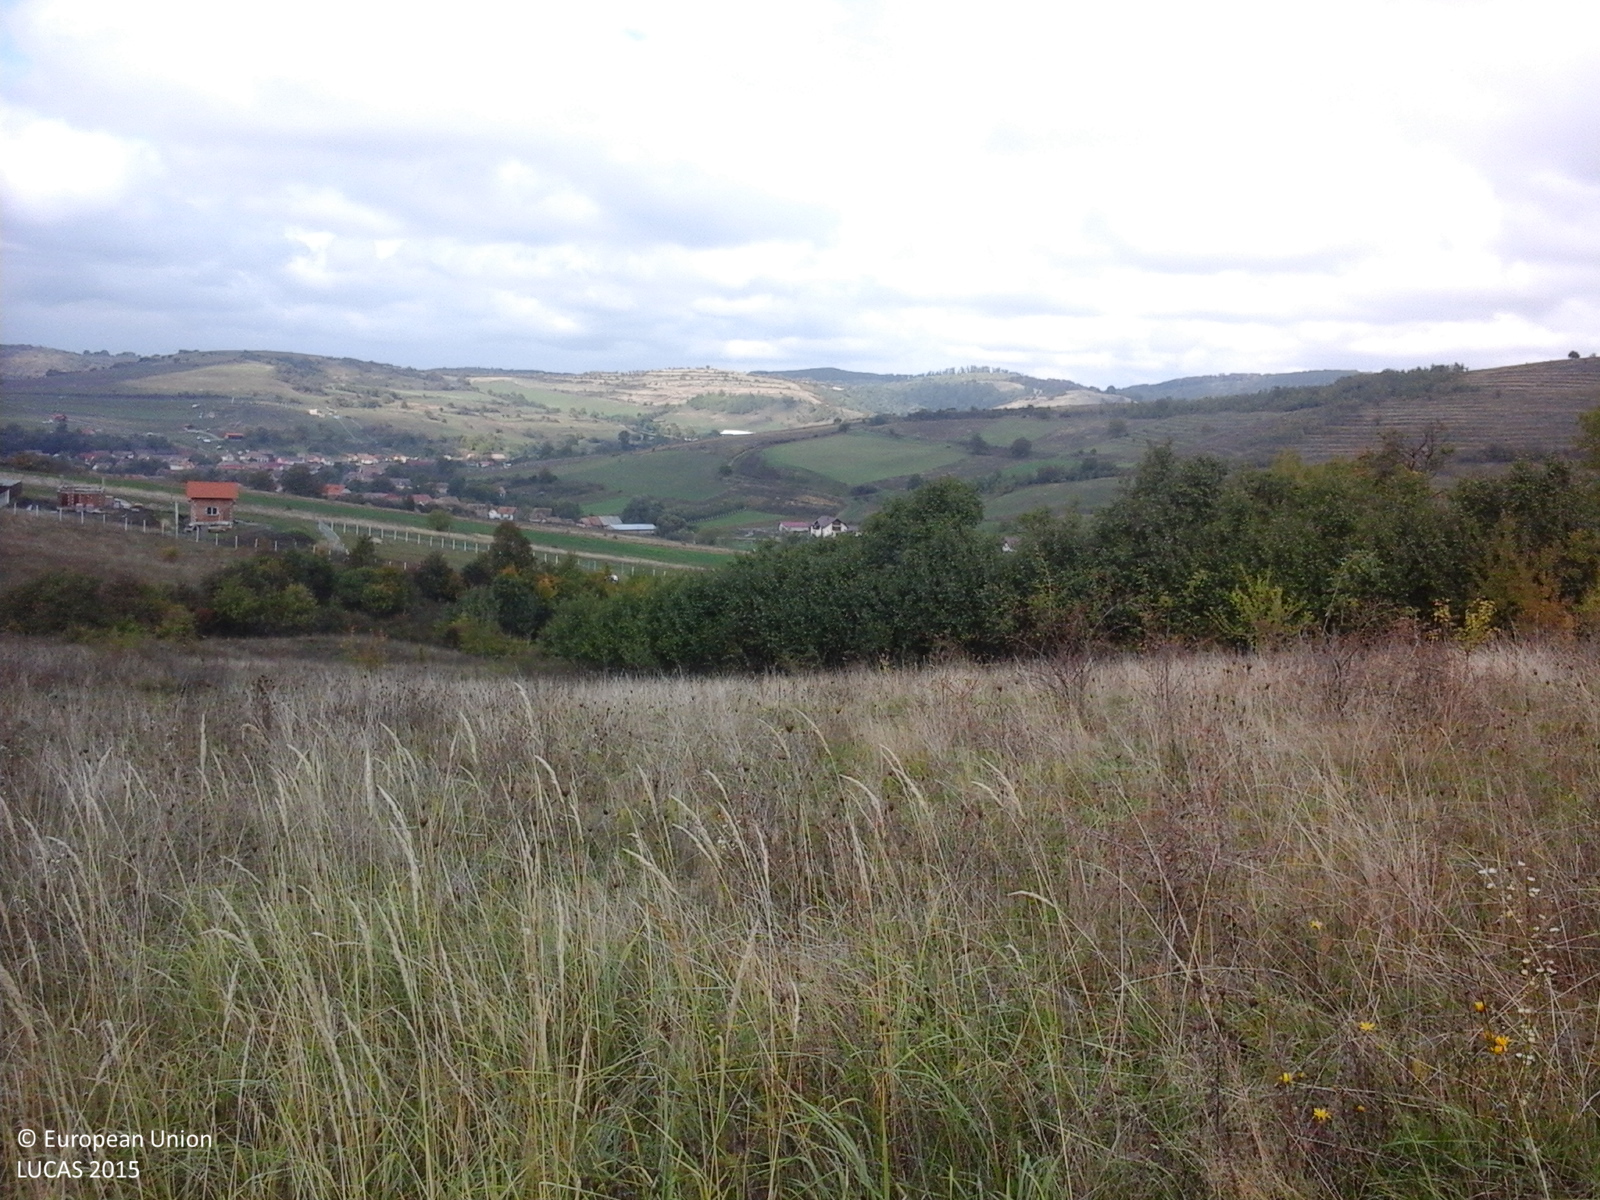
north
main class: Grassland
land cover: Grassland with sparse tree/shrub cover
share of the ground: > 75 %
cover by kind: herbaceous plants 90 %, broadleaved forest trees 5 %, shrubs 5 %
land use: Agriculture (excluding fallow land and kitchen gardens)
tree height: > 5 m
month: October
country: RO
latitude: 45.8543
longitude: 24.2042
